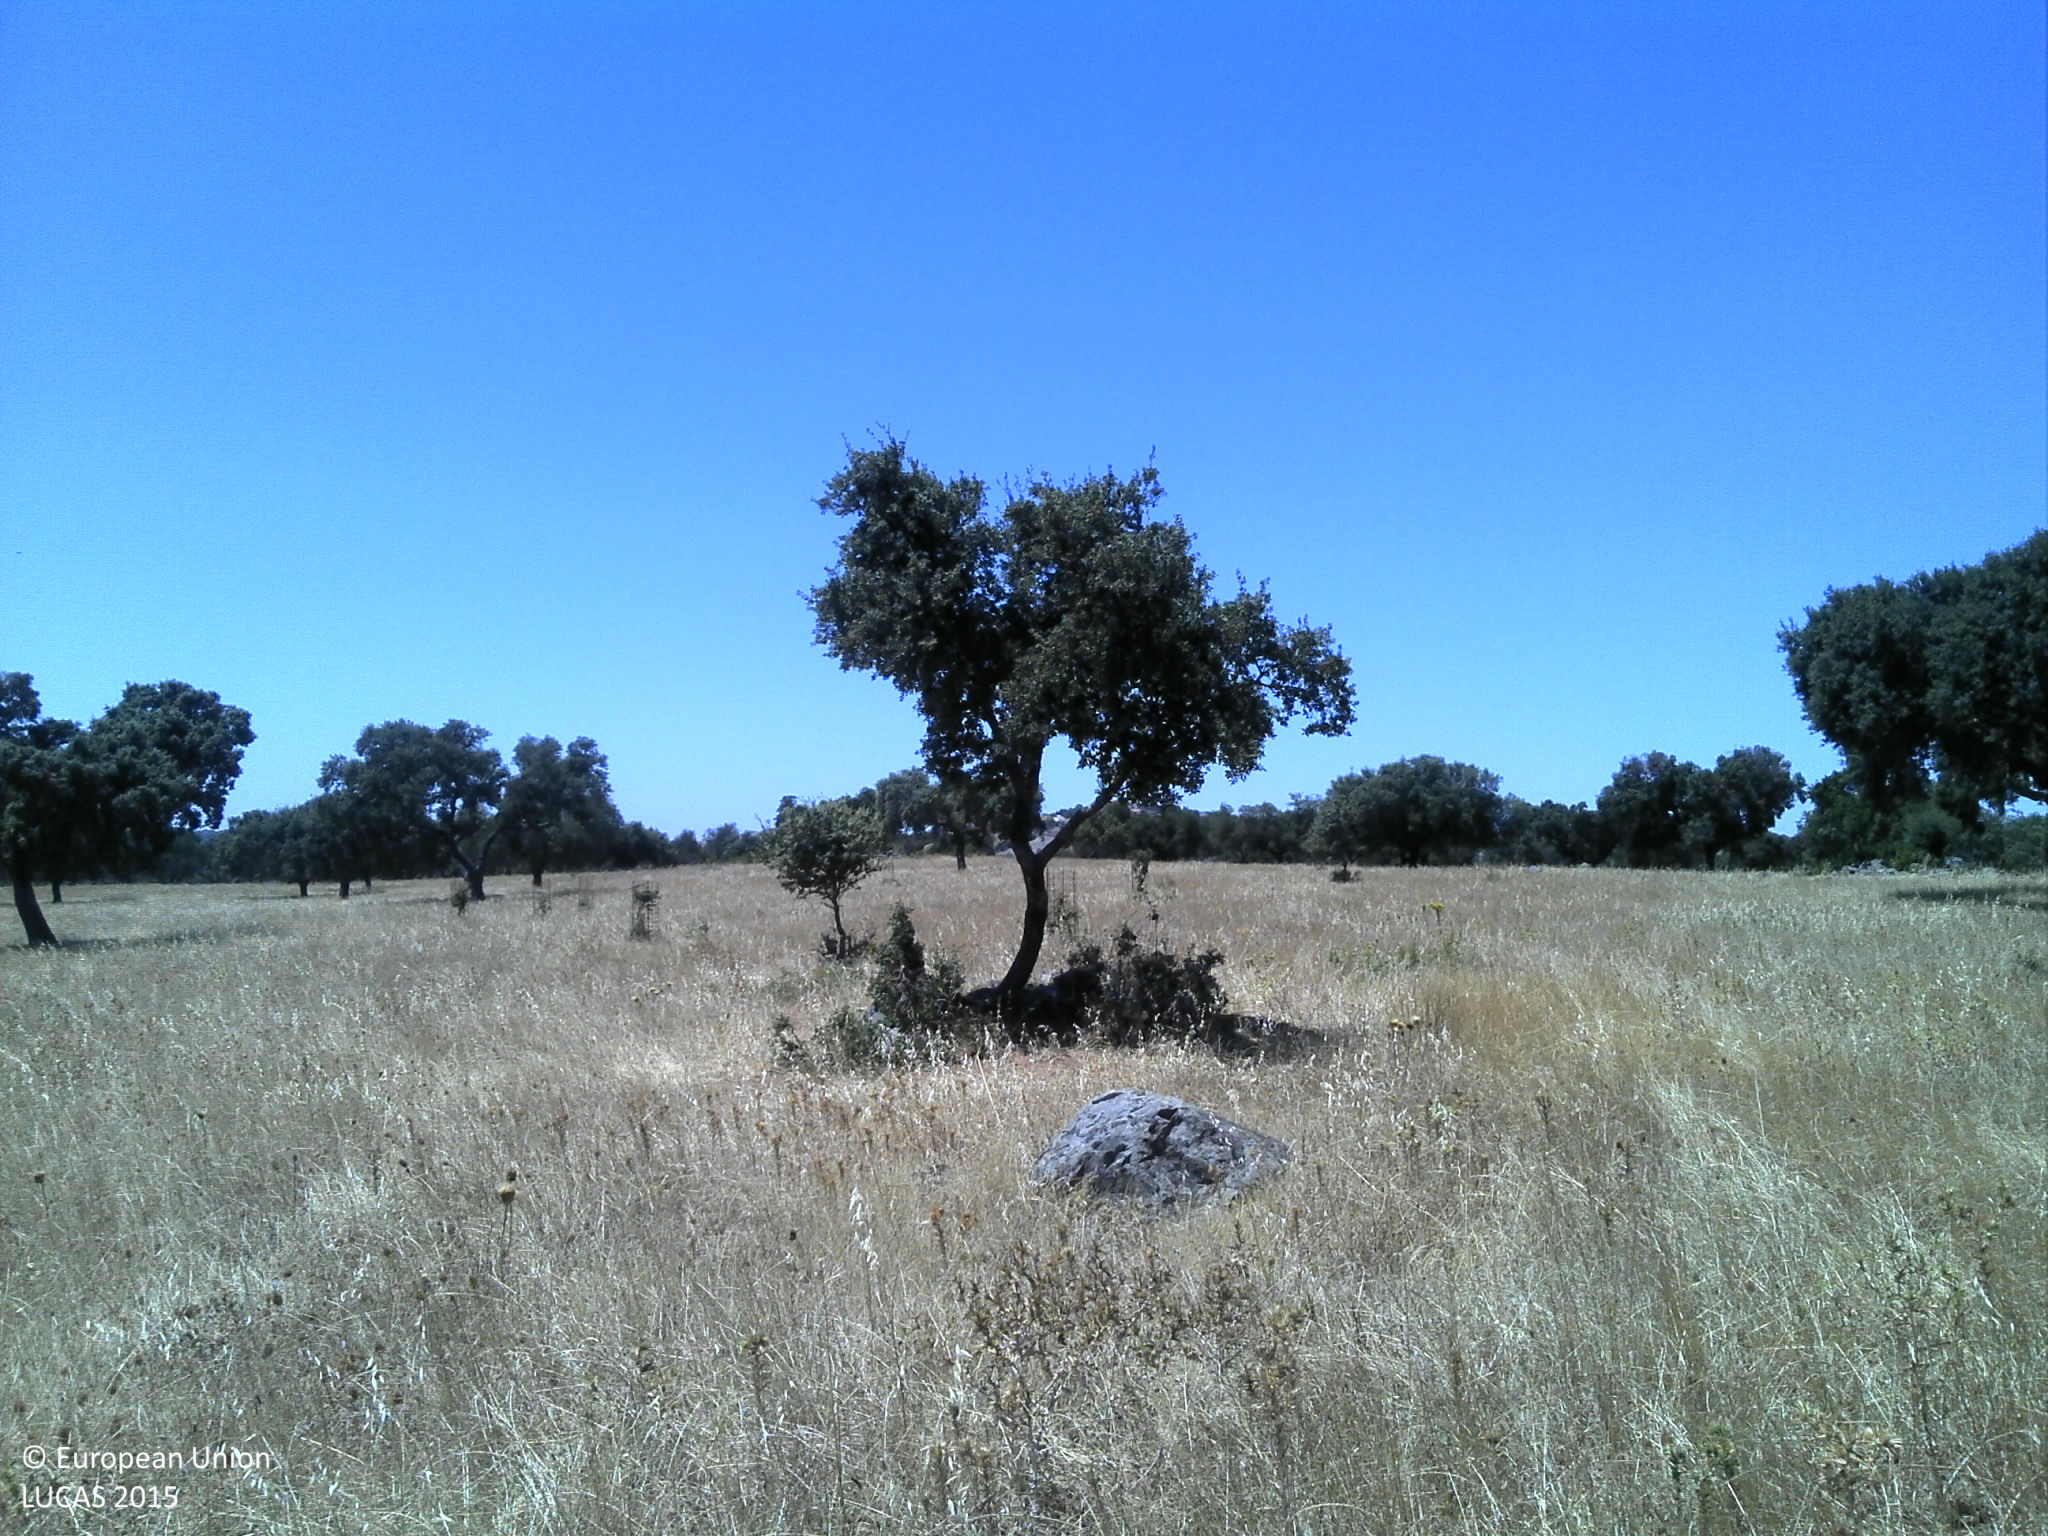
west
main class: Woodland
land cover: Broadleaved woodland
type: broadleaved evergreen forest
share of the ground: 10 - 25 %
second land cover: Grassland without tree/shrub cover
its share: 25 - 50 %
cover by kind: unconsolidated bare surface 55 %, herbaceous plants 25 %, broadleaved forest trees 20 %
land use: Forestry
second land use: Agriculture (excluding fallow land and kitchen gardens)
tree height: > 5 m
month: July
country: PT
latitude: 39.1299
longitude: -7.5670
